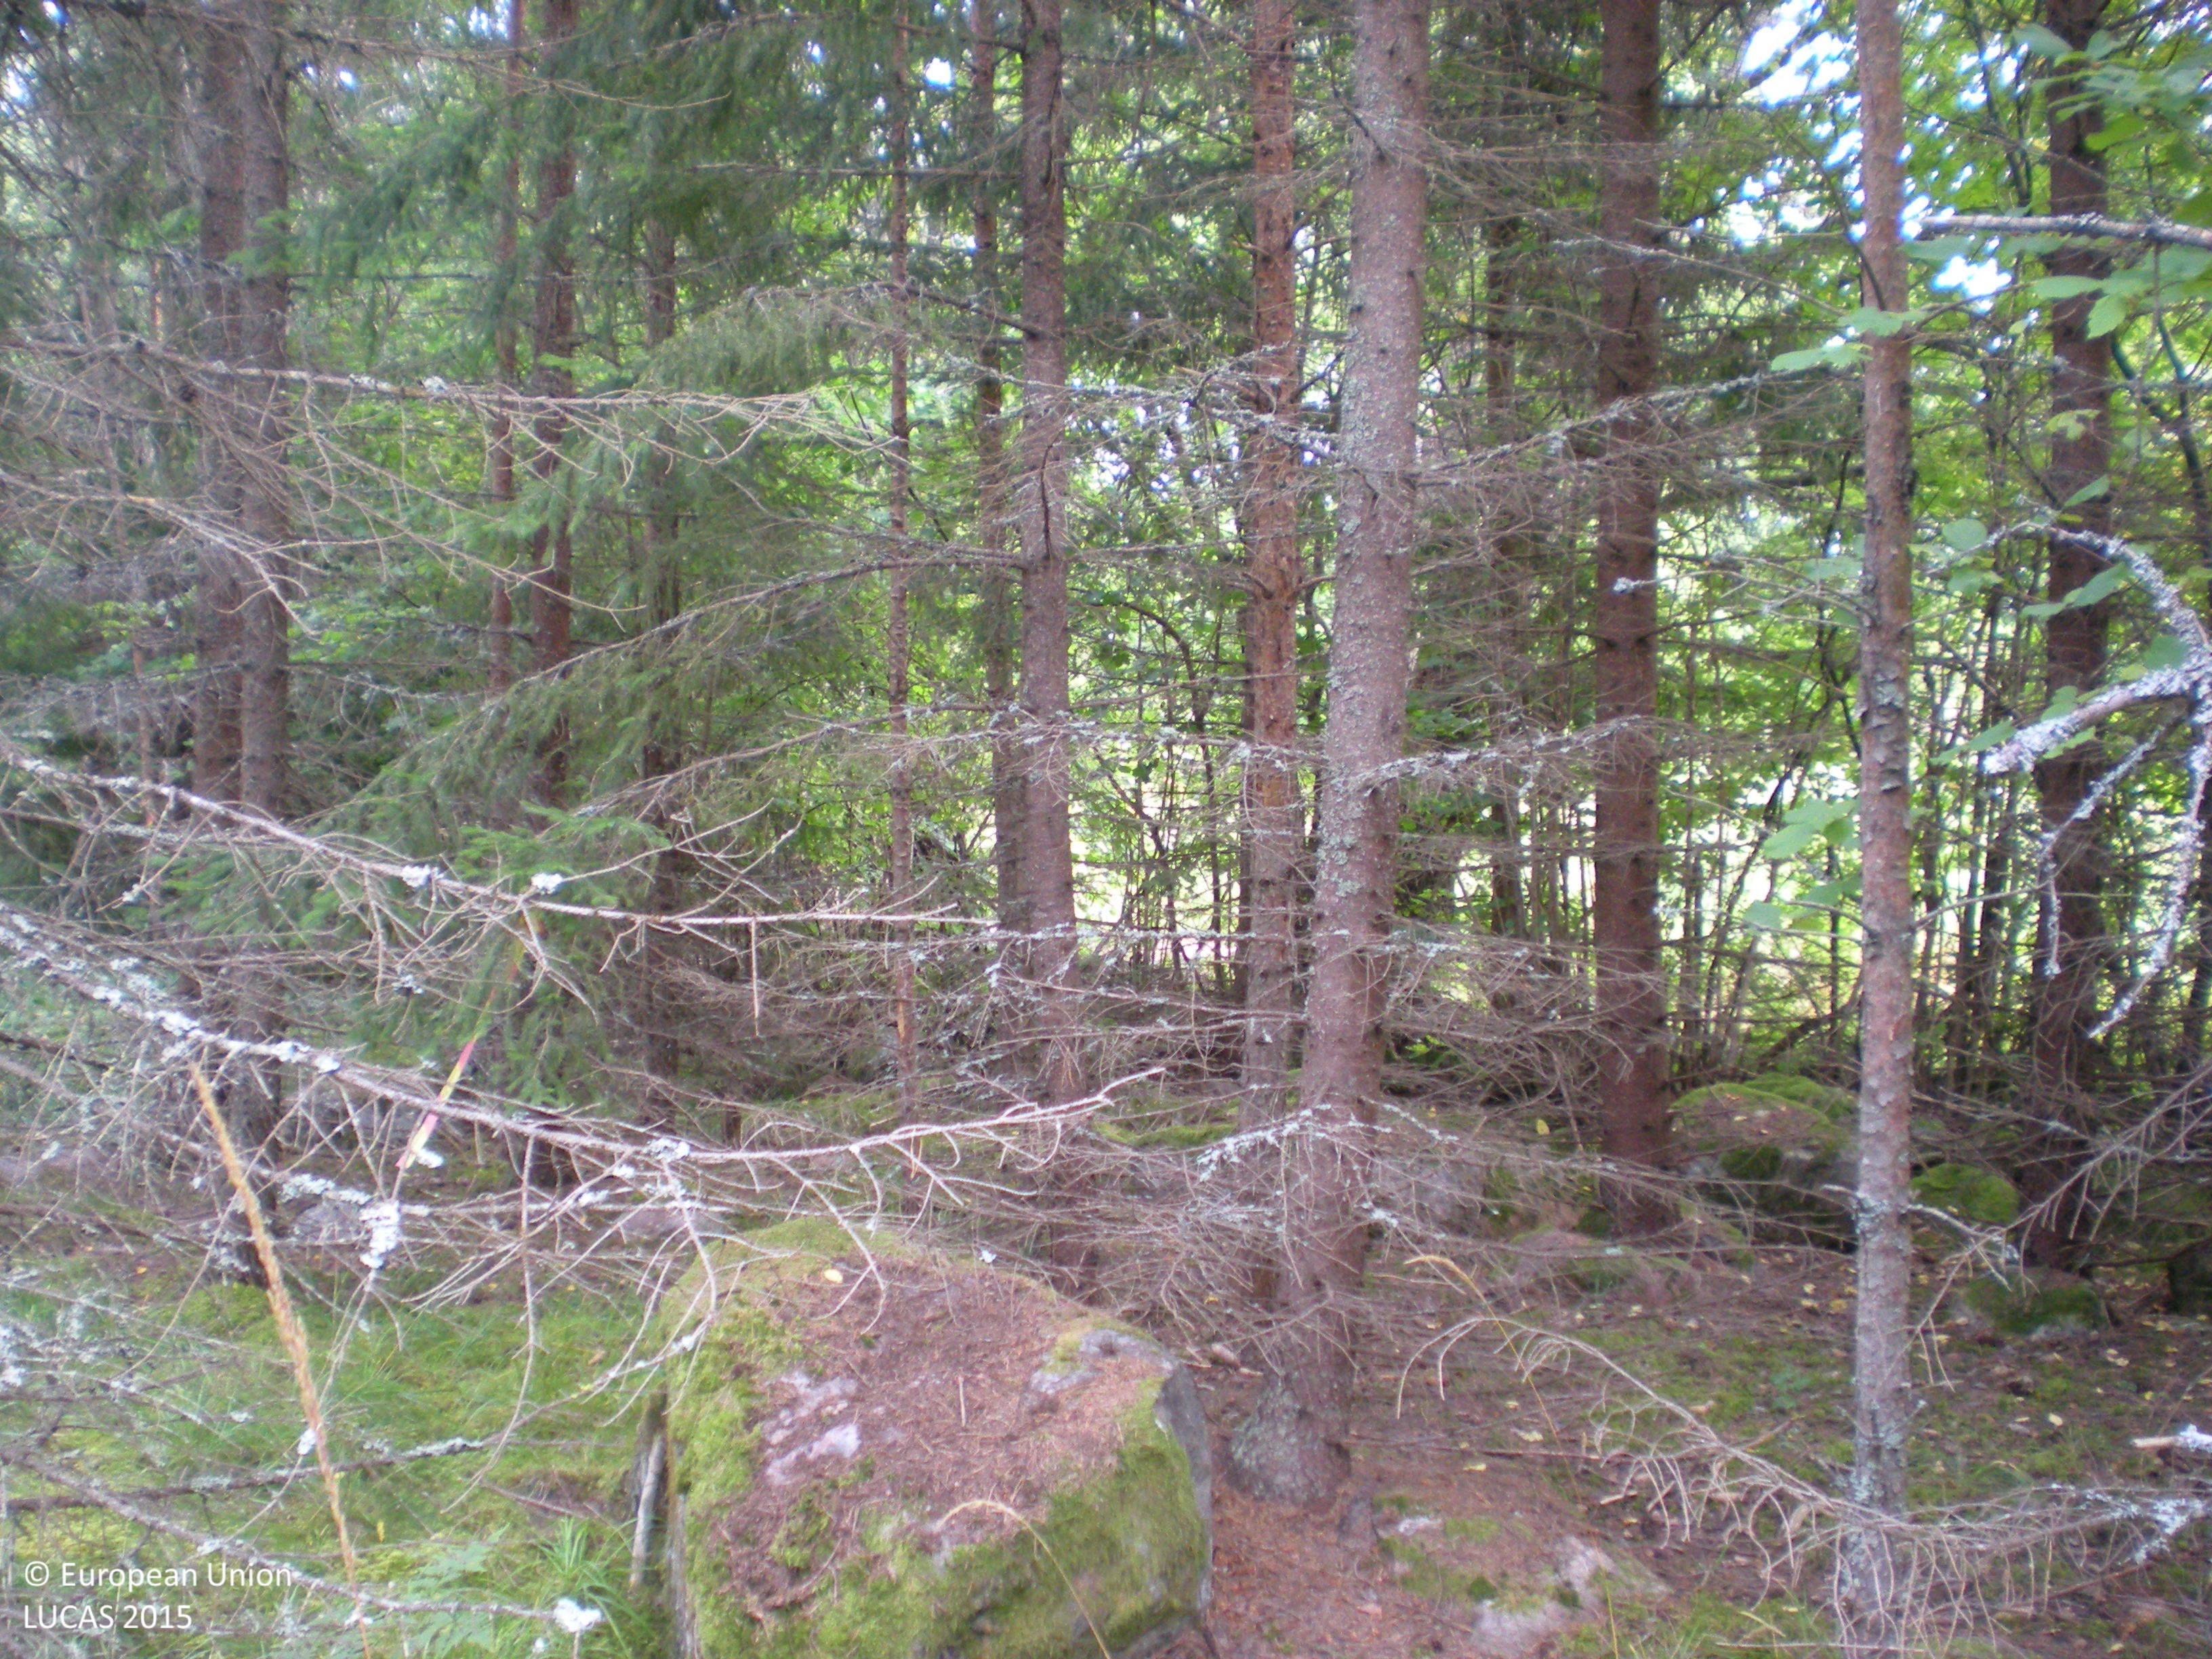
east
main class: Woodland
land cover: Other coniferous woodland
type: boreal forest
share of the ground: 50 - 75 %
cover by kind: coniferous forest trees 65 %, herbaceous plants 20 %, broadleaved forest trees 5 %, shrubs 5 %, lichens and mosses 5 %
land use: Forestry
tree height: > 5 m
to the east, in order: Other coniferous woodland; Broadleaved woodland; Fences; Grassland with sparse tree/shrub cover; Ditches and canals; Broadleaved woodland; Fences; Grassland without tree/shrub cover; Broadleaved woodland; Grassland with sparse tree/shrub cover
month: August
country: SE
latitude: 60.4637
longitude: 17.6110
